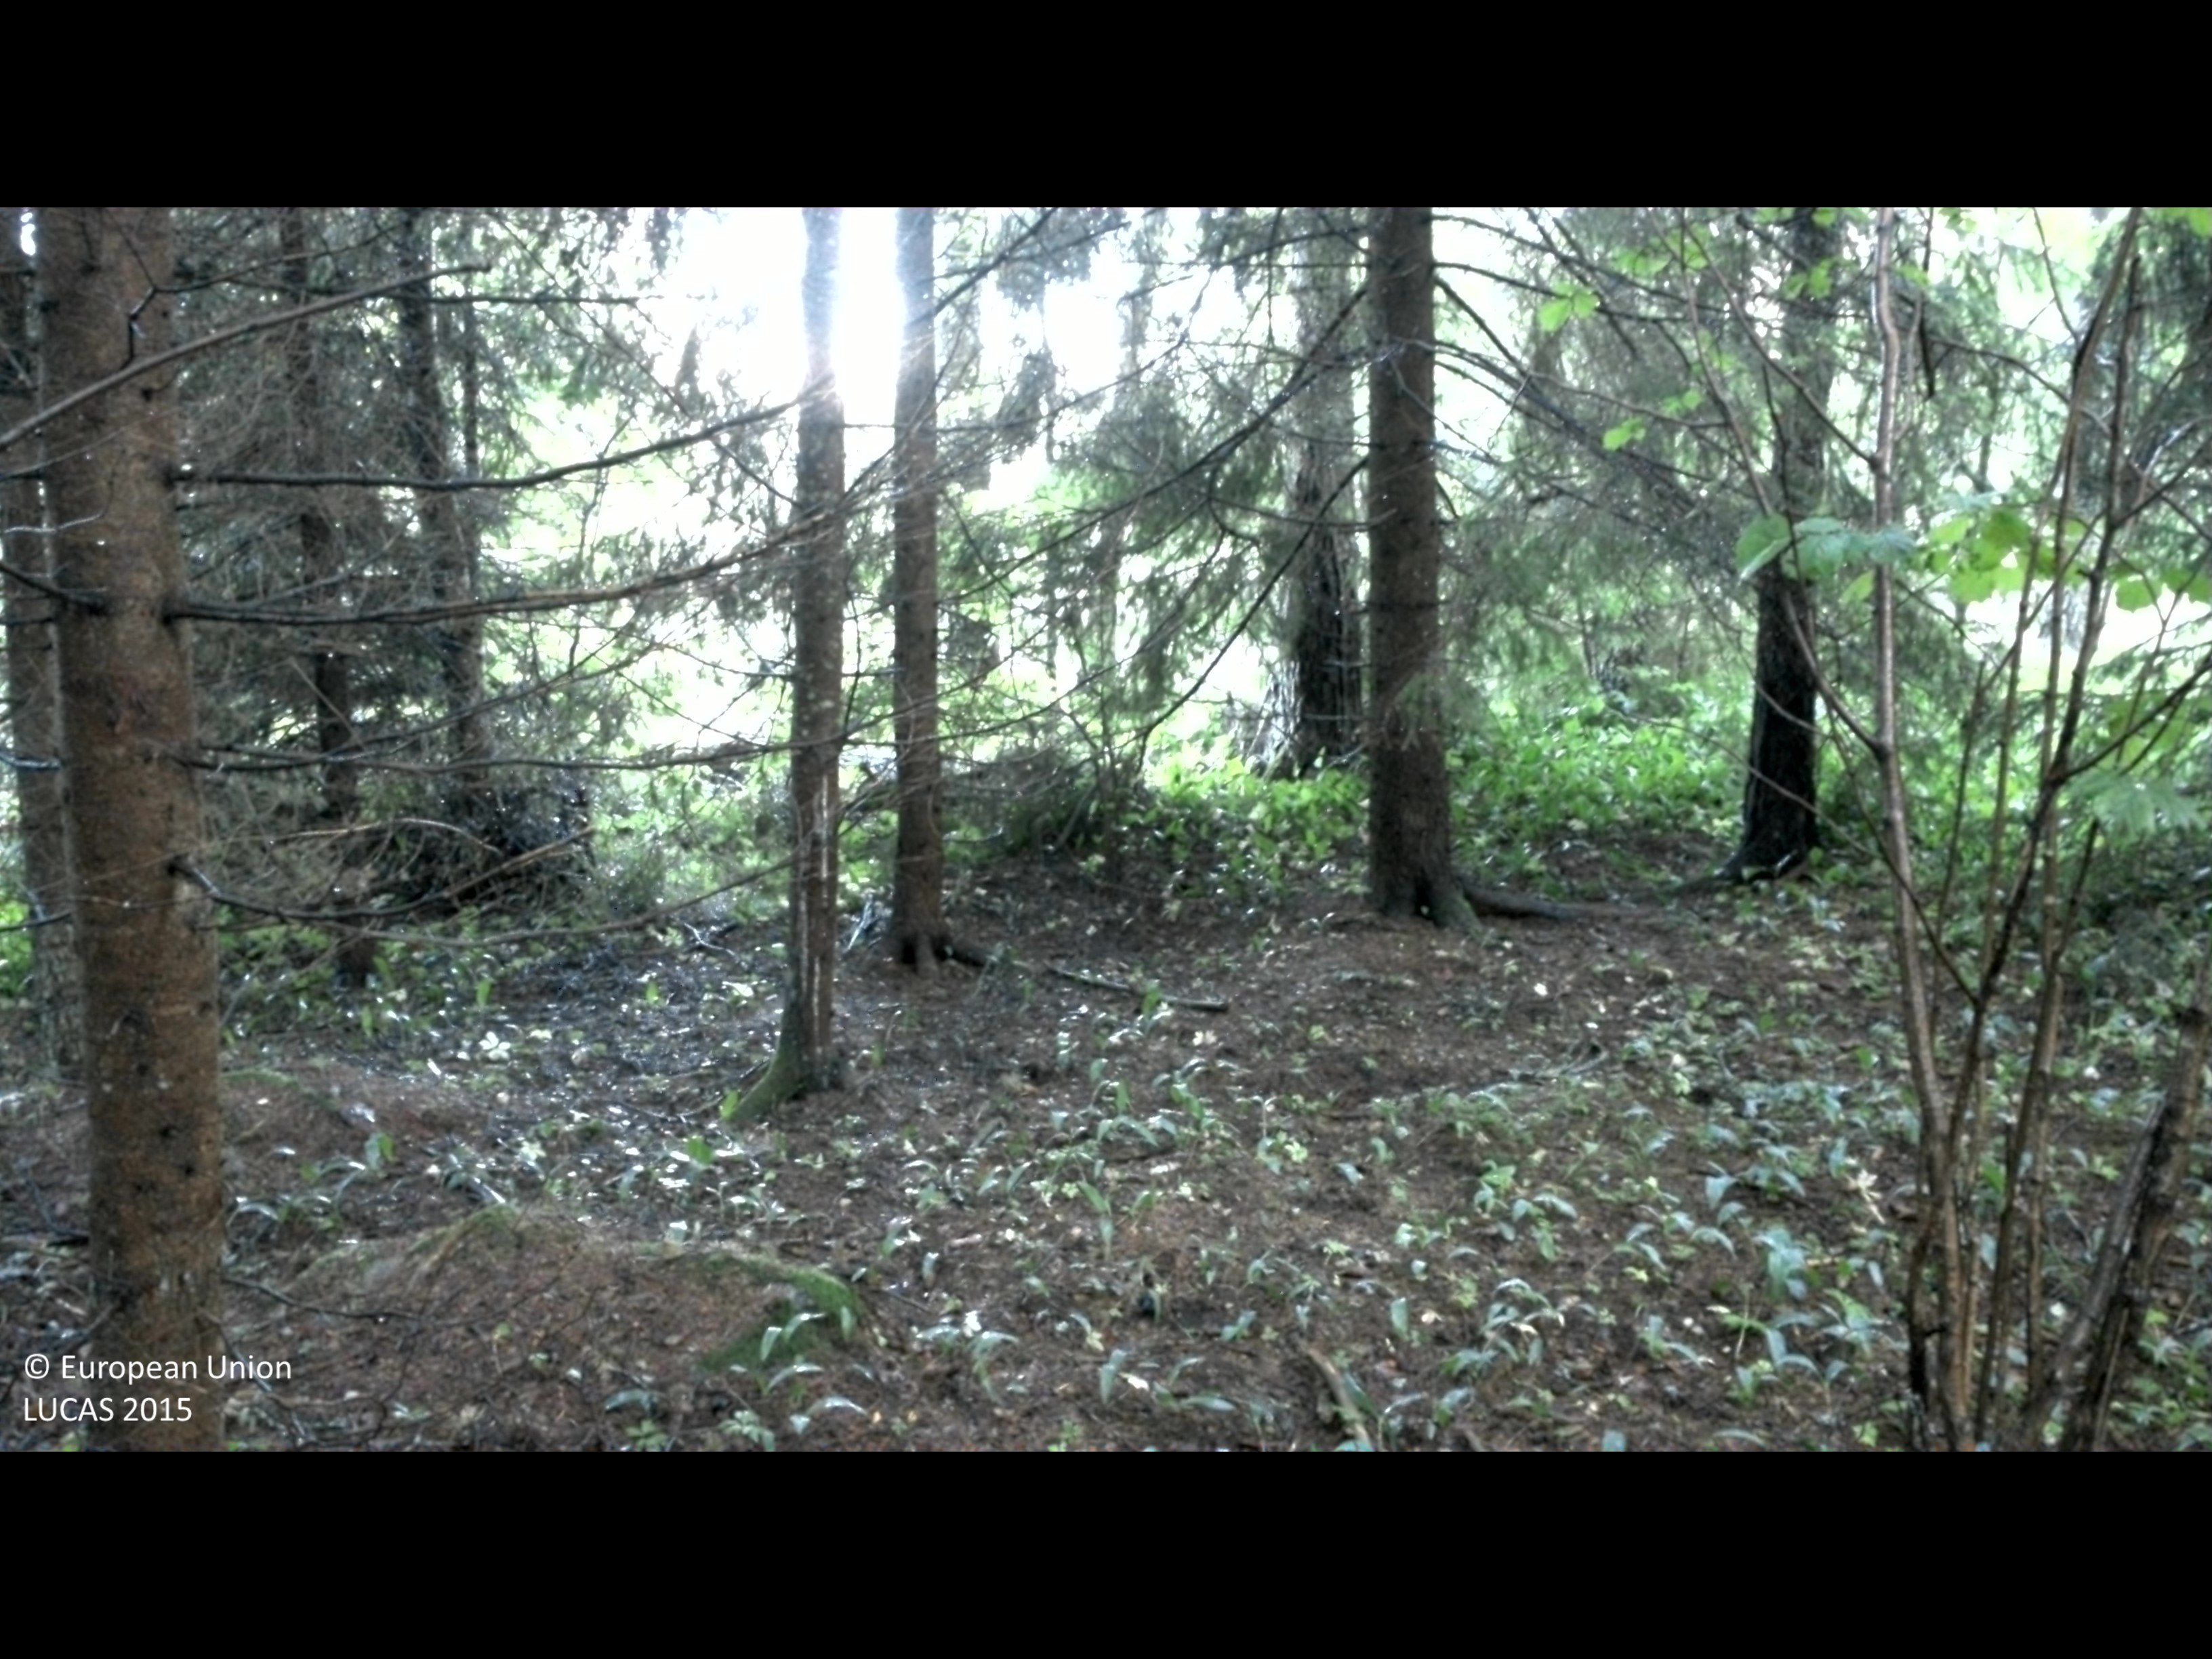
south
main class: Woodland
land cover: Spruce dominated coniferous woodland
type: boreal forest
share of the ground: > 75 %
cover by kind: coniferous forest trees 70 %, broadleaved forest trees 20 %, shrubs 5 %, herbaceous plants 5 %
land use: Forestry
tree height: > 5 m
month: June
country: SE
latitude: 58.0787
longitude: 16.1518
